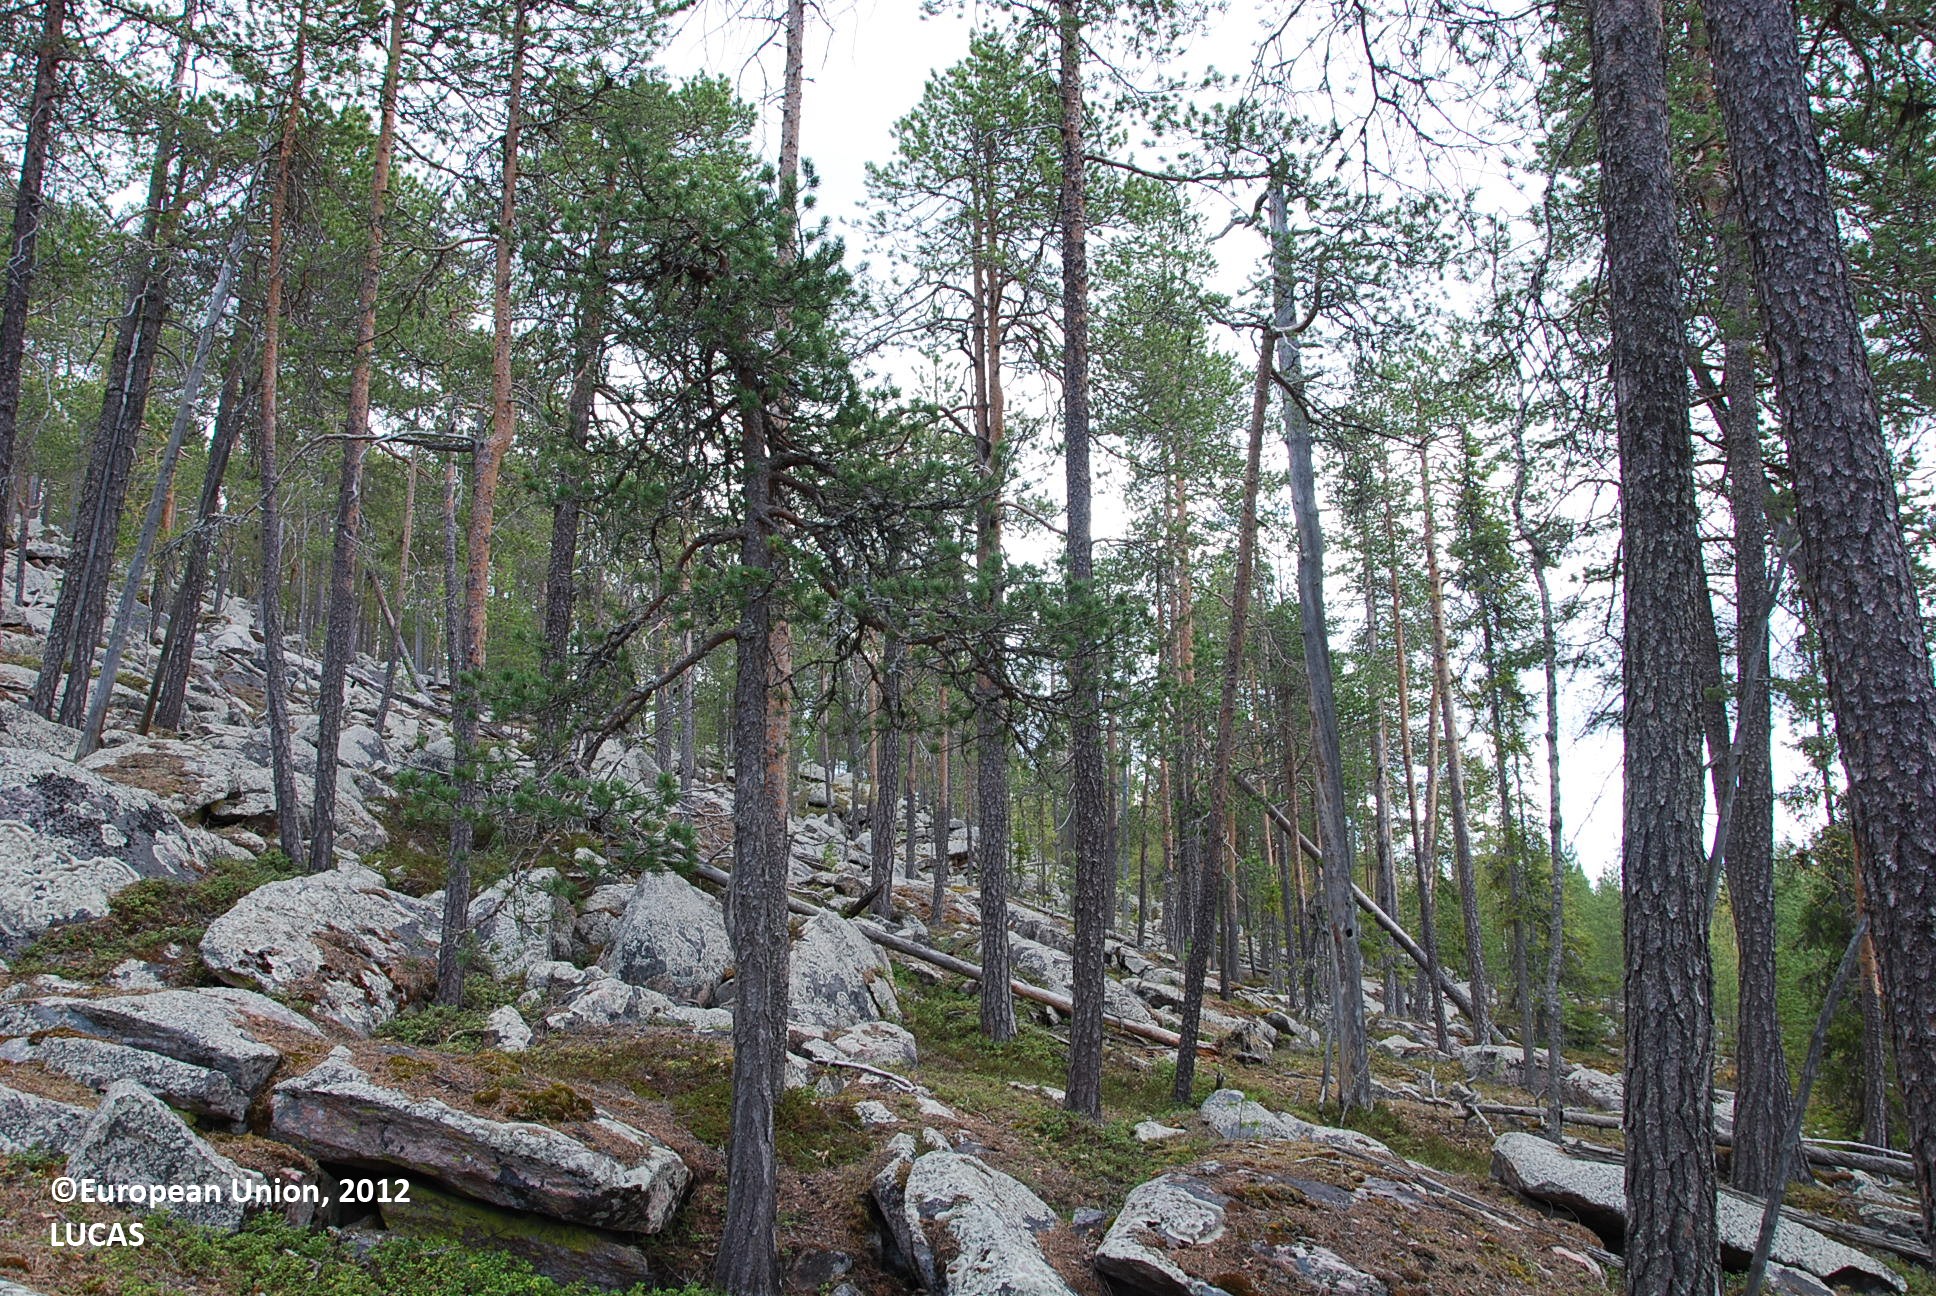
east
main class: Woodland
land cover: Pine dominated coniferous woodland
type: boreal forest
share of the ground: 25 - 50 %
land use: Forestry
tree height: > 5 m
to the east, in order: Pine dominated coniferous woodland
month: May
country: FI
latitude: 66.8914
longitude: 28.2842
